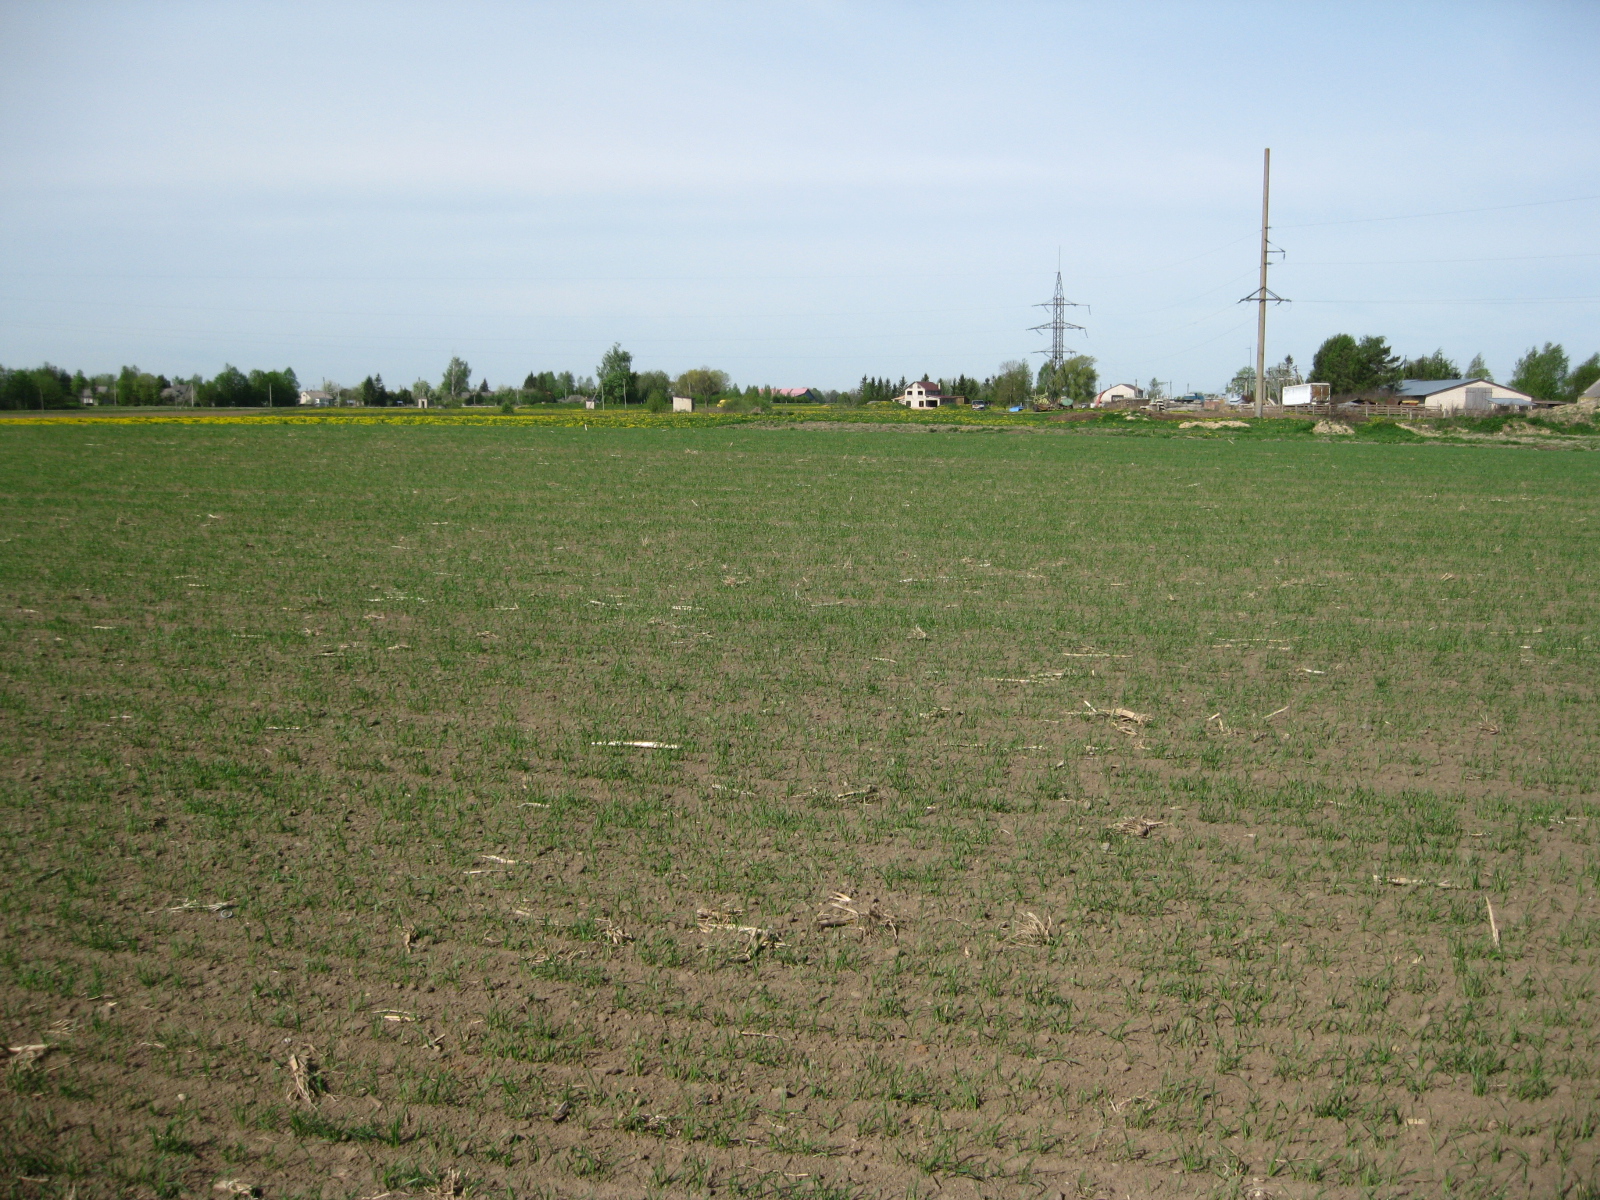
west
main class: Cropland
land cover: Common wheat
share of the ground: < 10 %
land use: Agriculture (excluding fallow land and kitchen gardens)
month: May
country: LT
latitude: 56.1769
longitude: 24.2183
